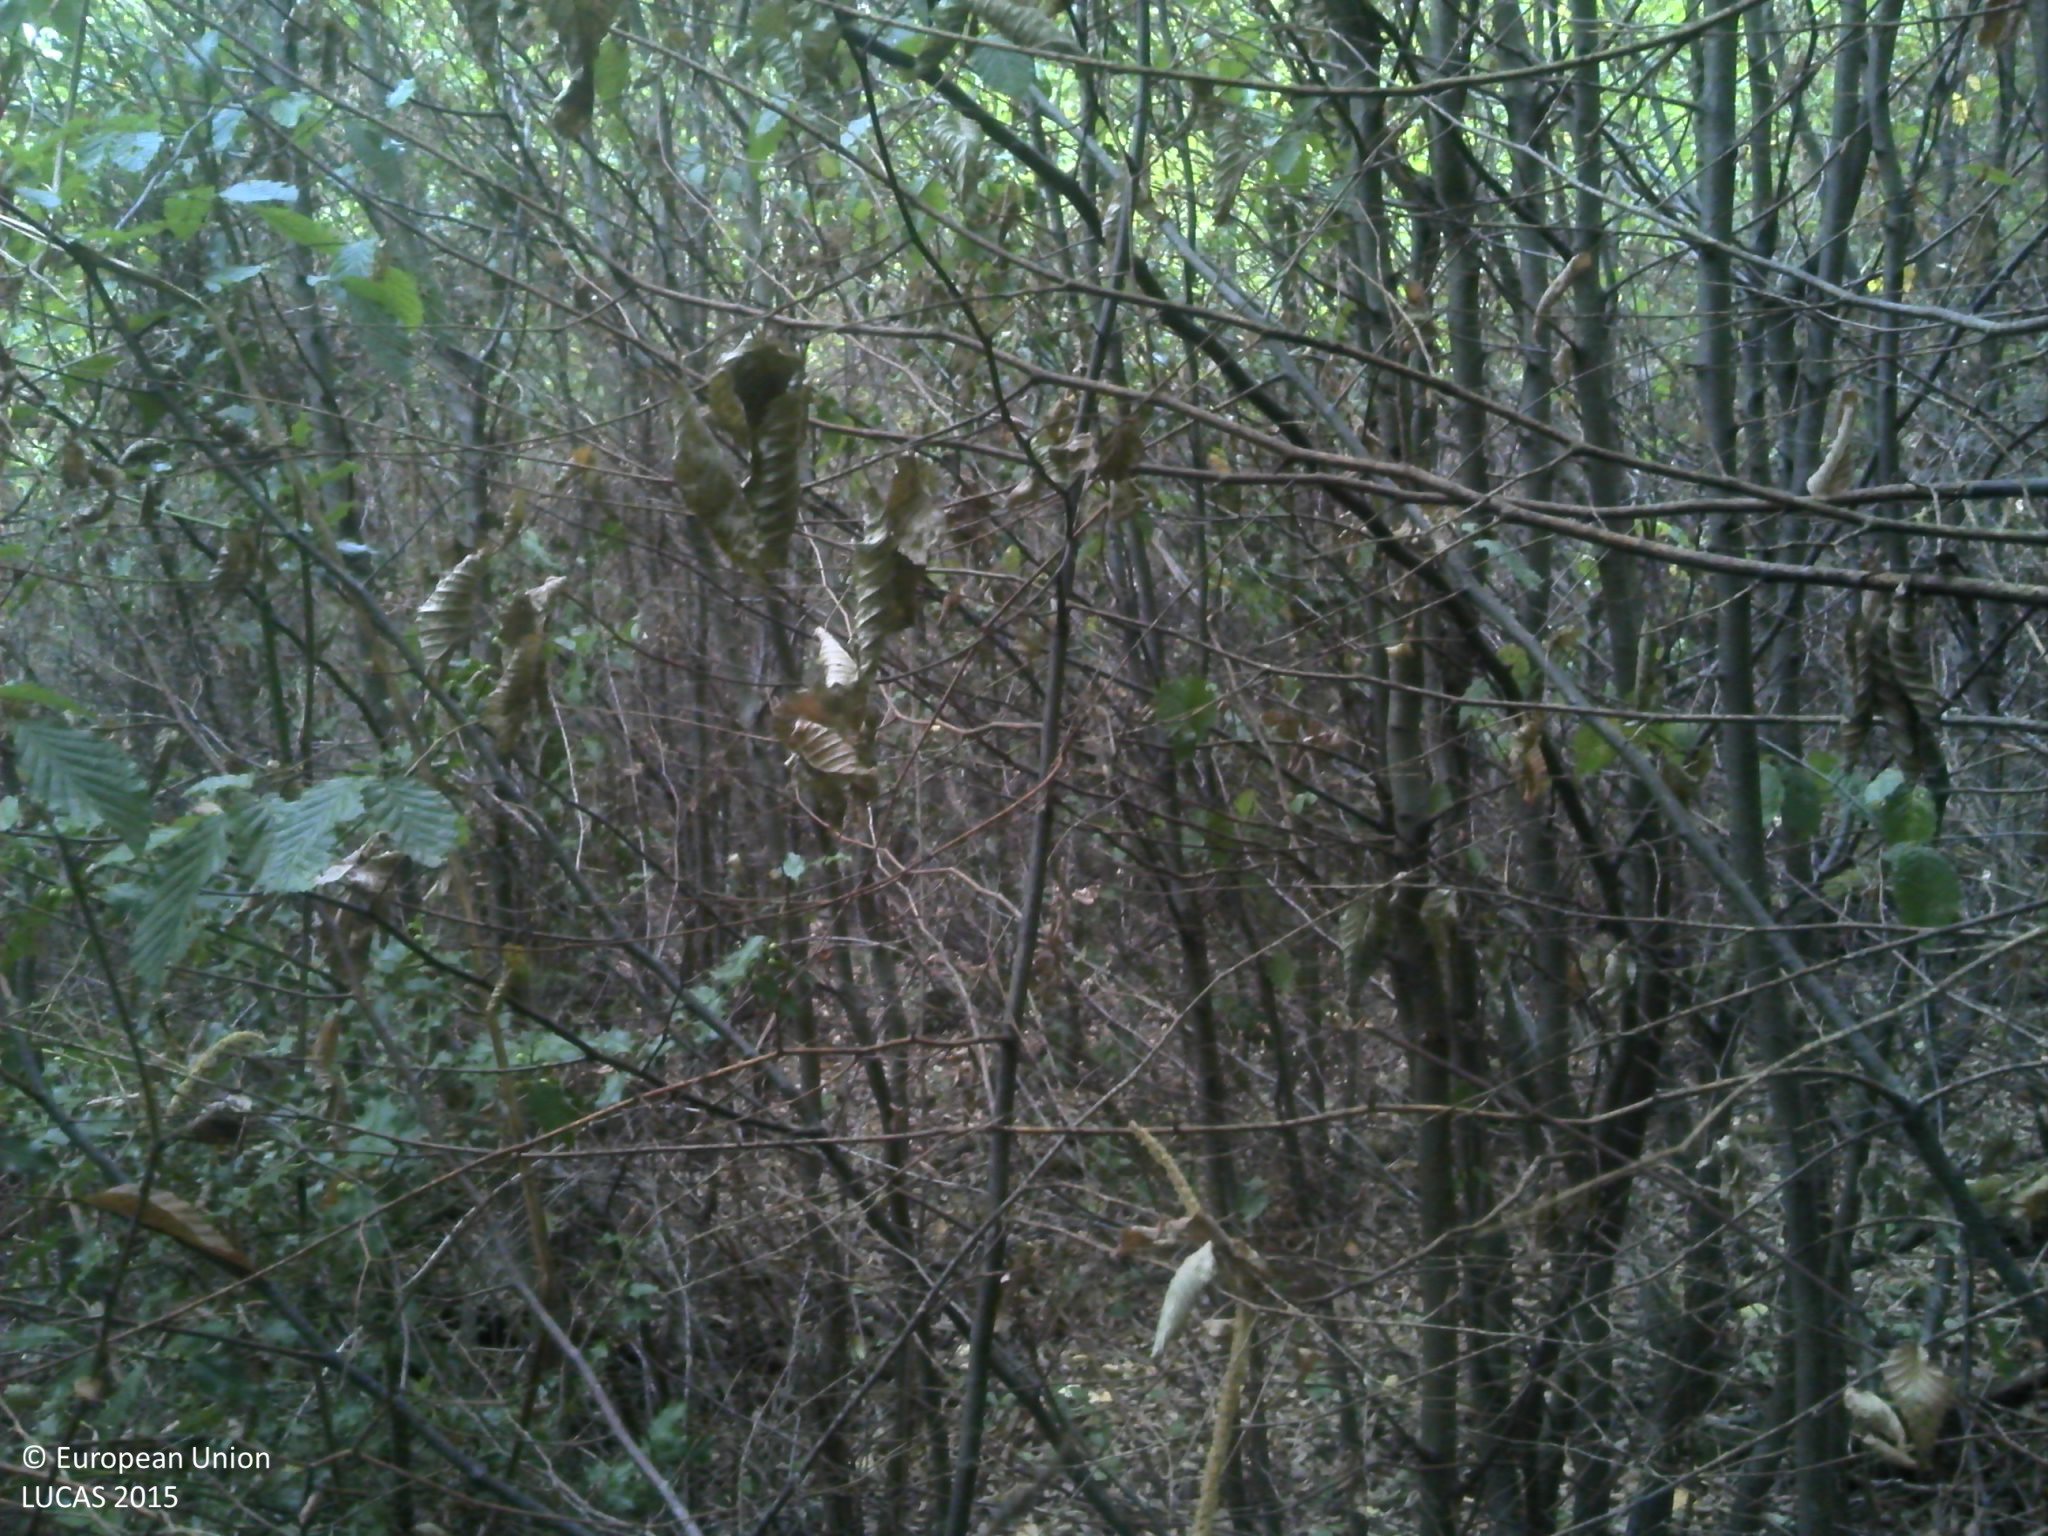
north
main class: Woodland
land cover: Broadleaved woodland
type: acidophilous oak and oak-birch forest
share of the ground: > 75 %
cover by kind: broadleaved forest trees 60 %, unconsolidated bare surface 30 %, herbaceous plants 5 %, lichens and mosses 5 %
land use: Semi-natural and natural areas not in use
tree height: > 5 m
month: July
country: FR
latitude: 45.0269
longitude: 1.8621
